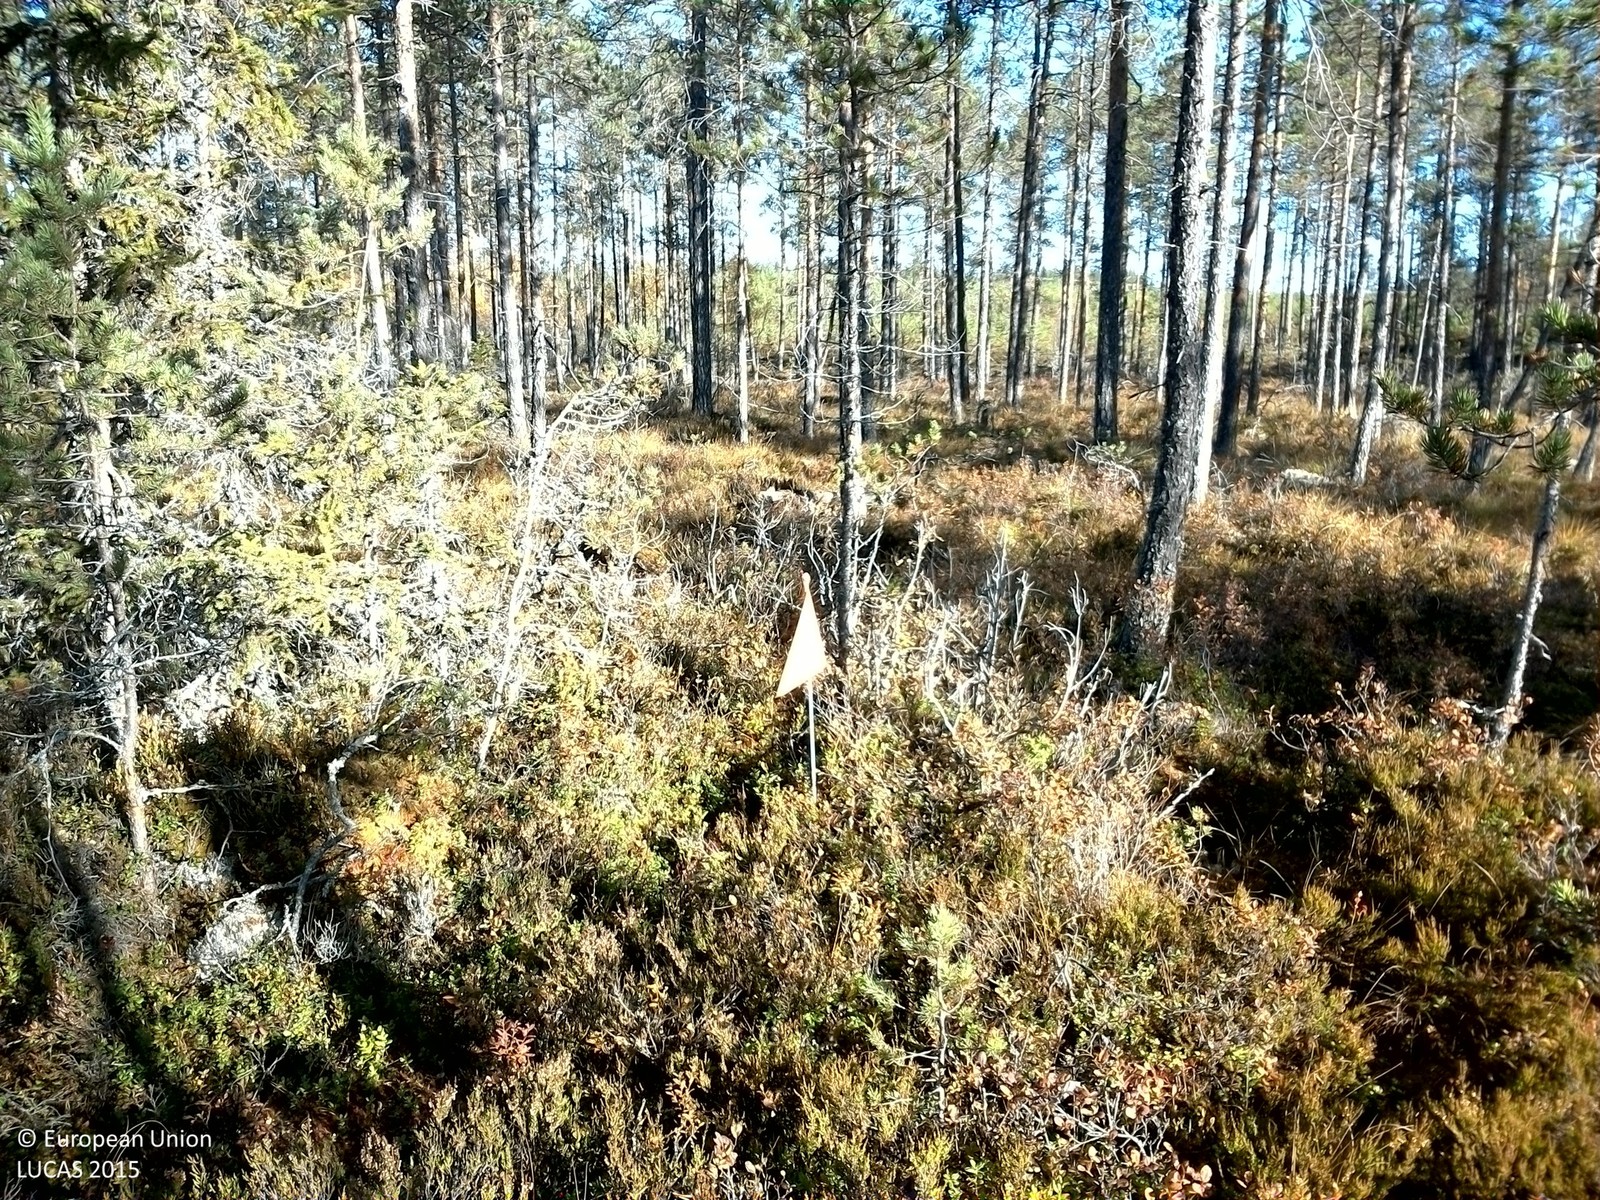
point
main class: Woodland
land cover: Pine dominated coniferous woodland
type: boreal forest
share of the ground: 50 - 75 %
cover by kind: coniferous forest trees 50 %, shrubs 30 %, lichens and mosses 15 %, herbaceous plants 5 %
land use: Forestry
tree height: > 5 m
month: October
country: SE
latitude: 61.1828
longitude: 15.2856
